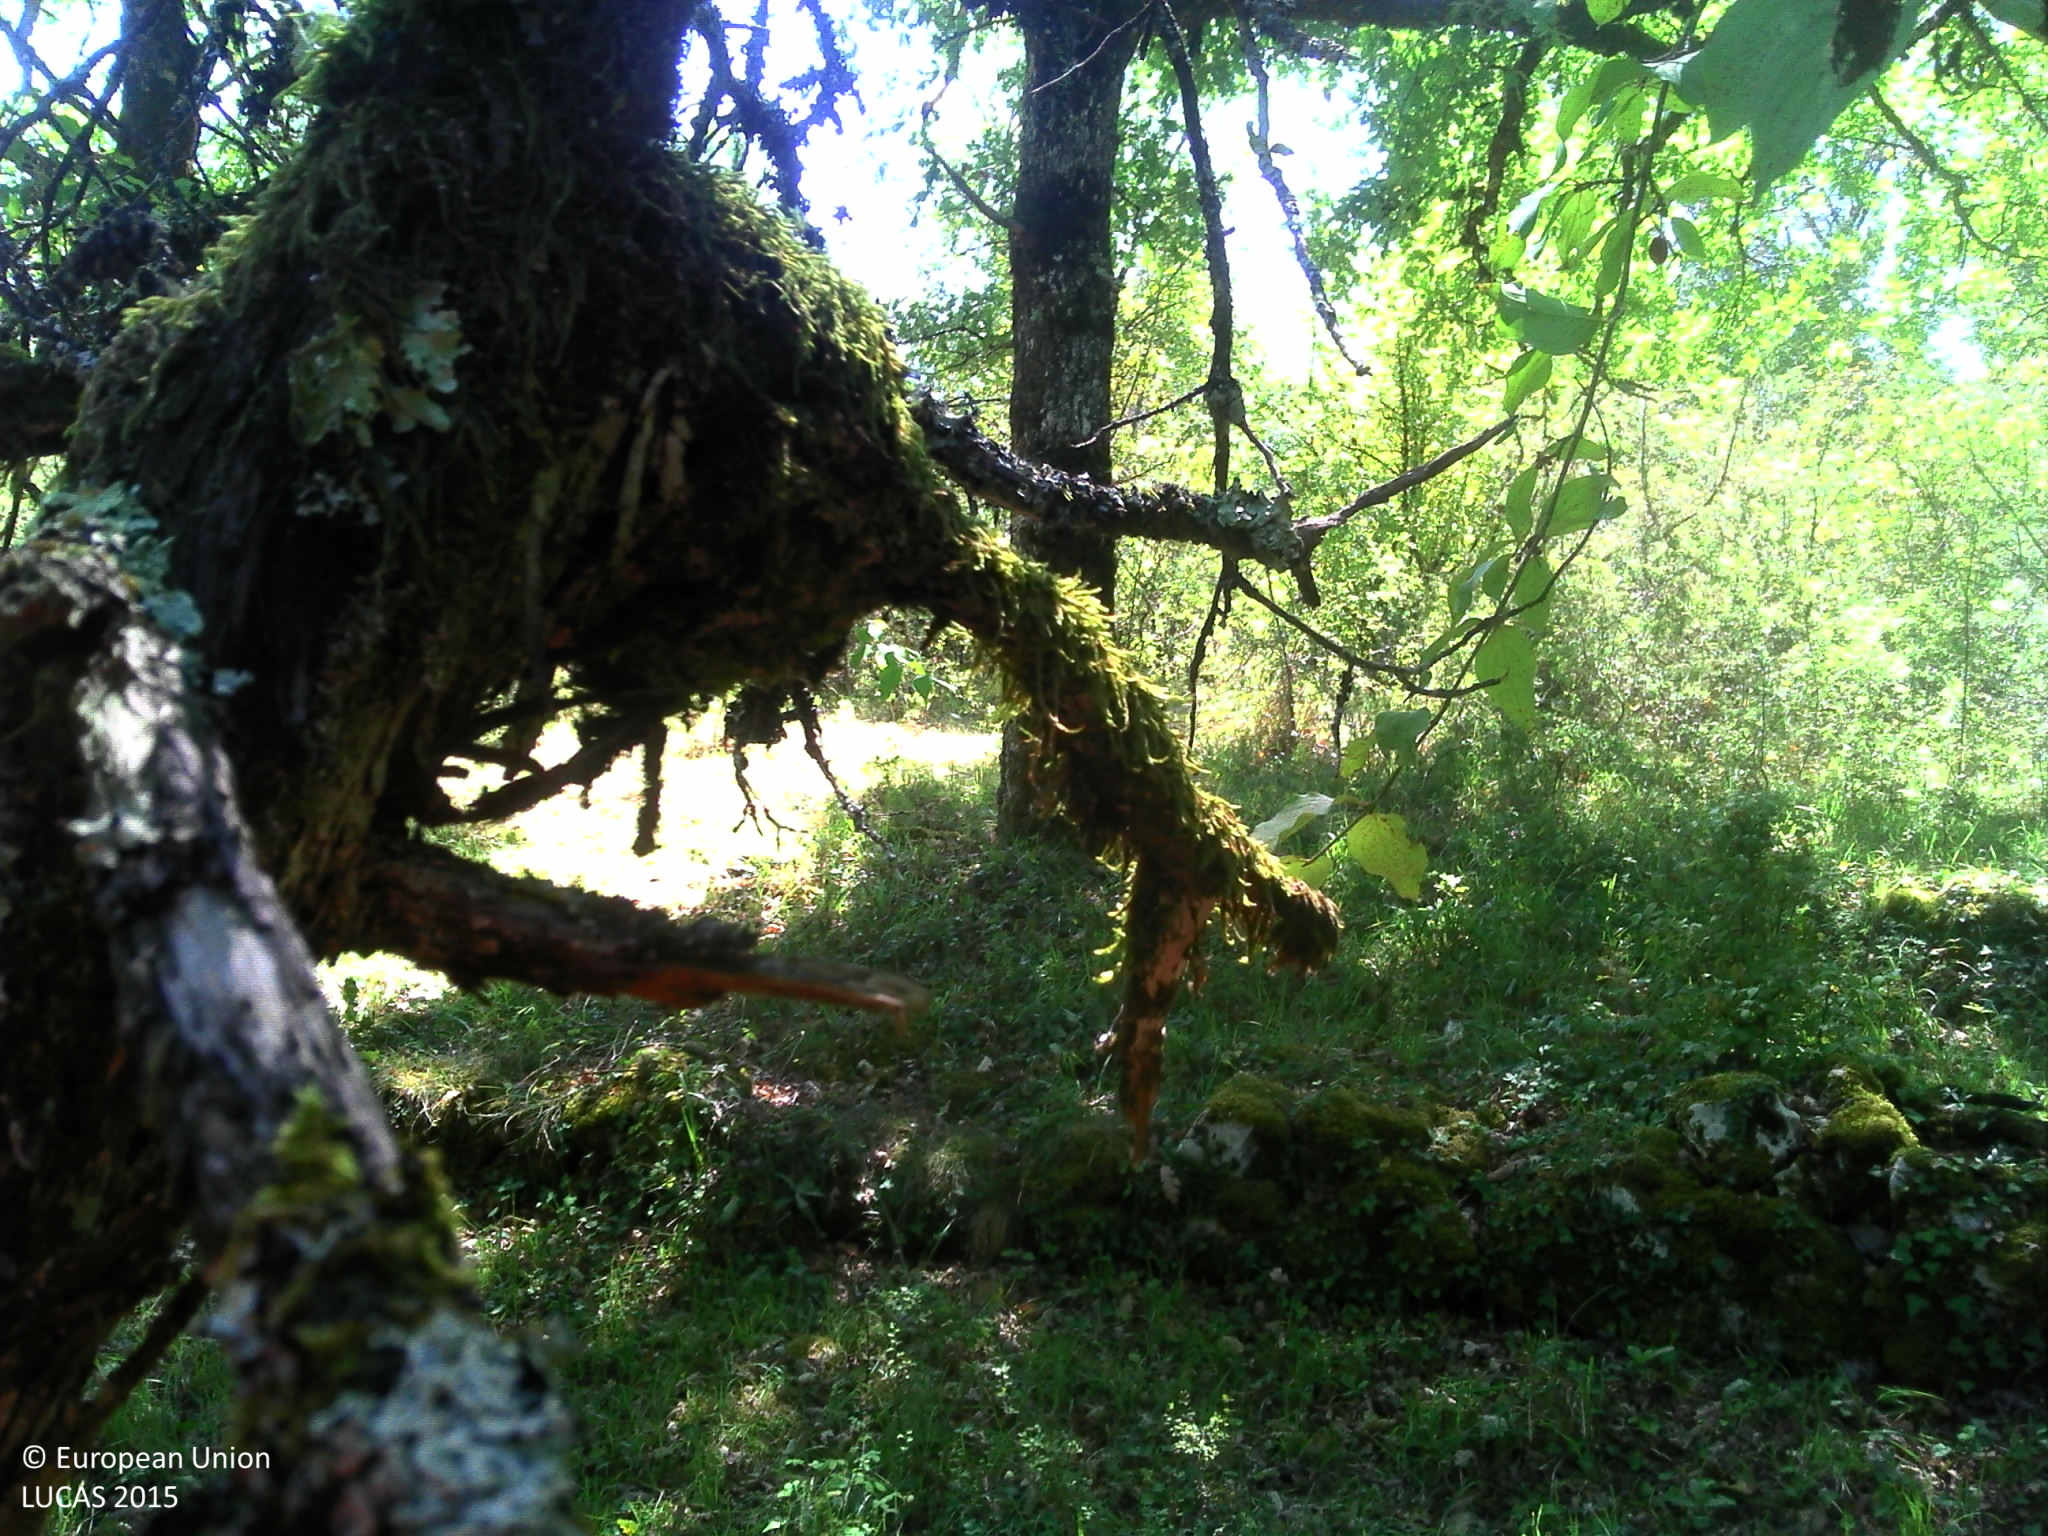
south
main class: Woodland
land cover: Broadleaved woodland
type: mesophytic deciduous forest
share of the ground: > 75 %
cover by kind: broadleaved forest trees 60 %, shrubs 30 %, herbaceous plants 10 %
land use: Forestry
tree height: > 5 m
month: August
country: FR
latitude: 44.7306
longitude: 1.7784
